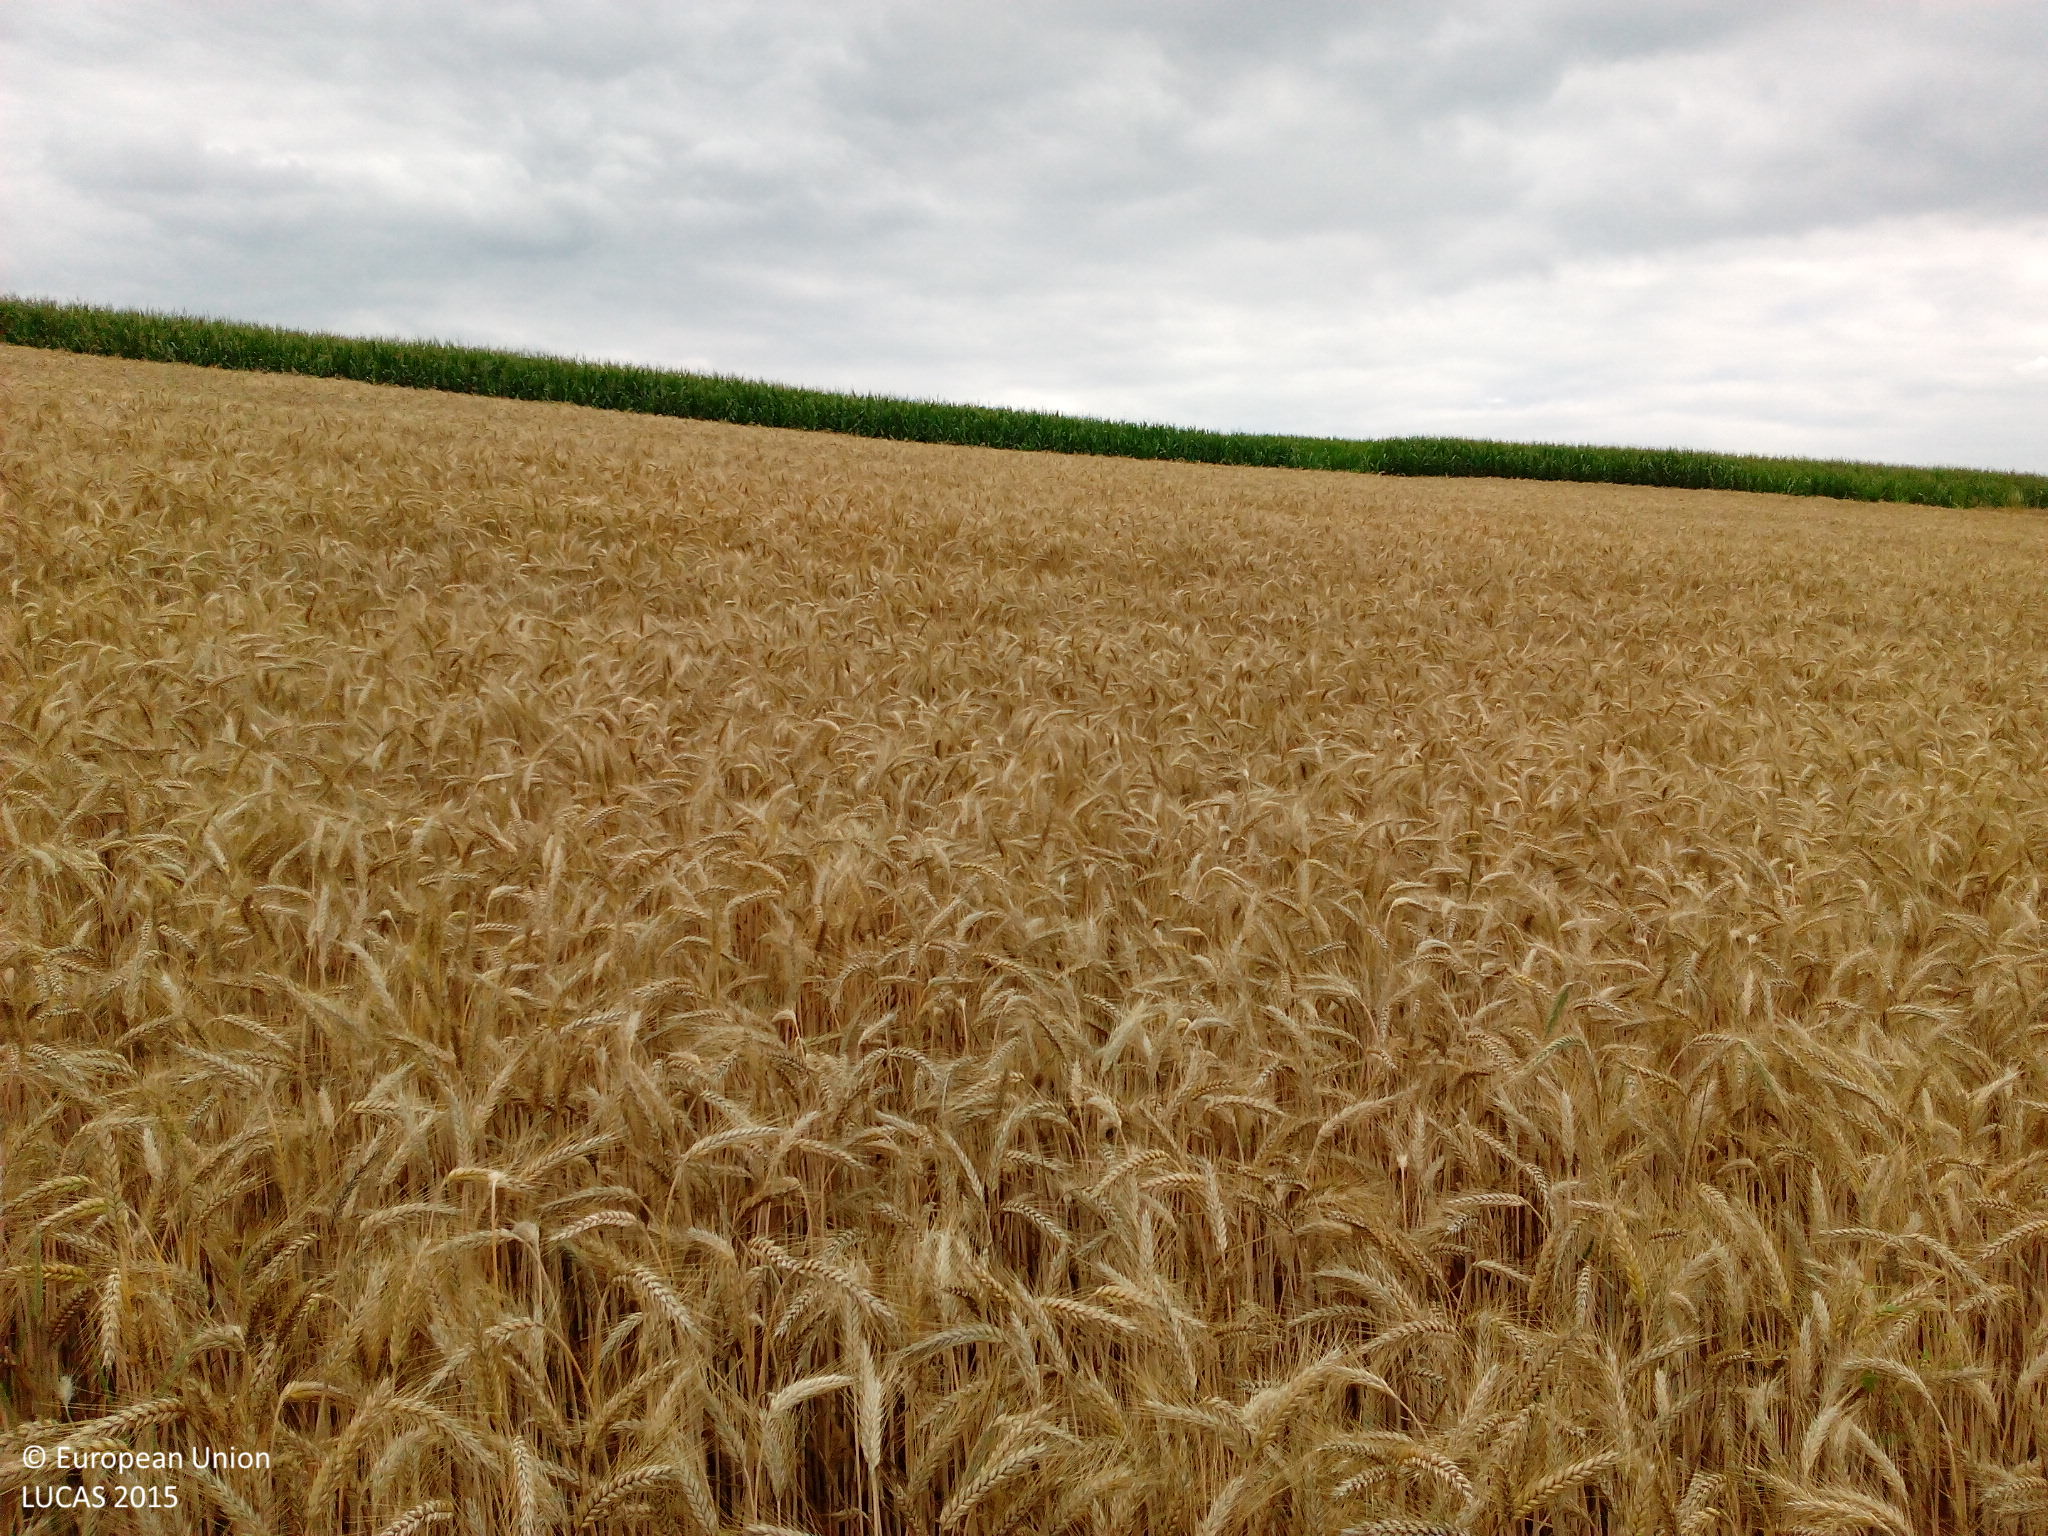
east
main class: Cropland
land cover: Barley
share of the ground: > 75 %
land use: Agriculture (excluding fallow land and kitchen gardens)
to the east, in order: Barley; Maize; Grass margins; Tracks; Grass margins; Maize; Grassland without tree/shrub cover; Barley
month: July
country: DE
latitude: 50.5078
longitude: 9.8731
